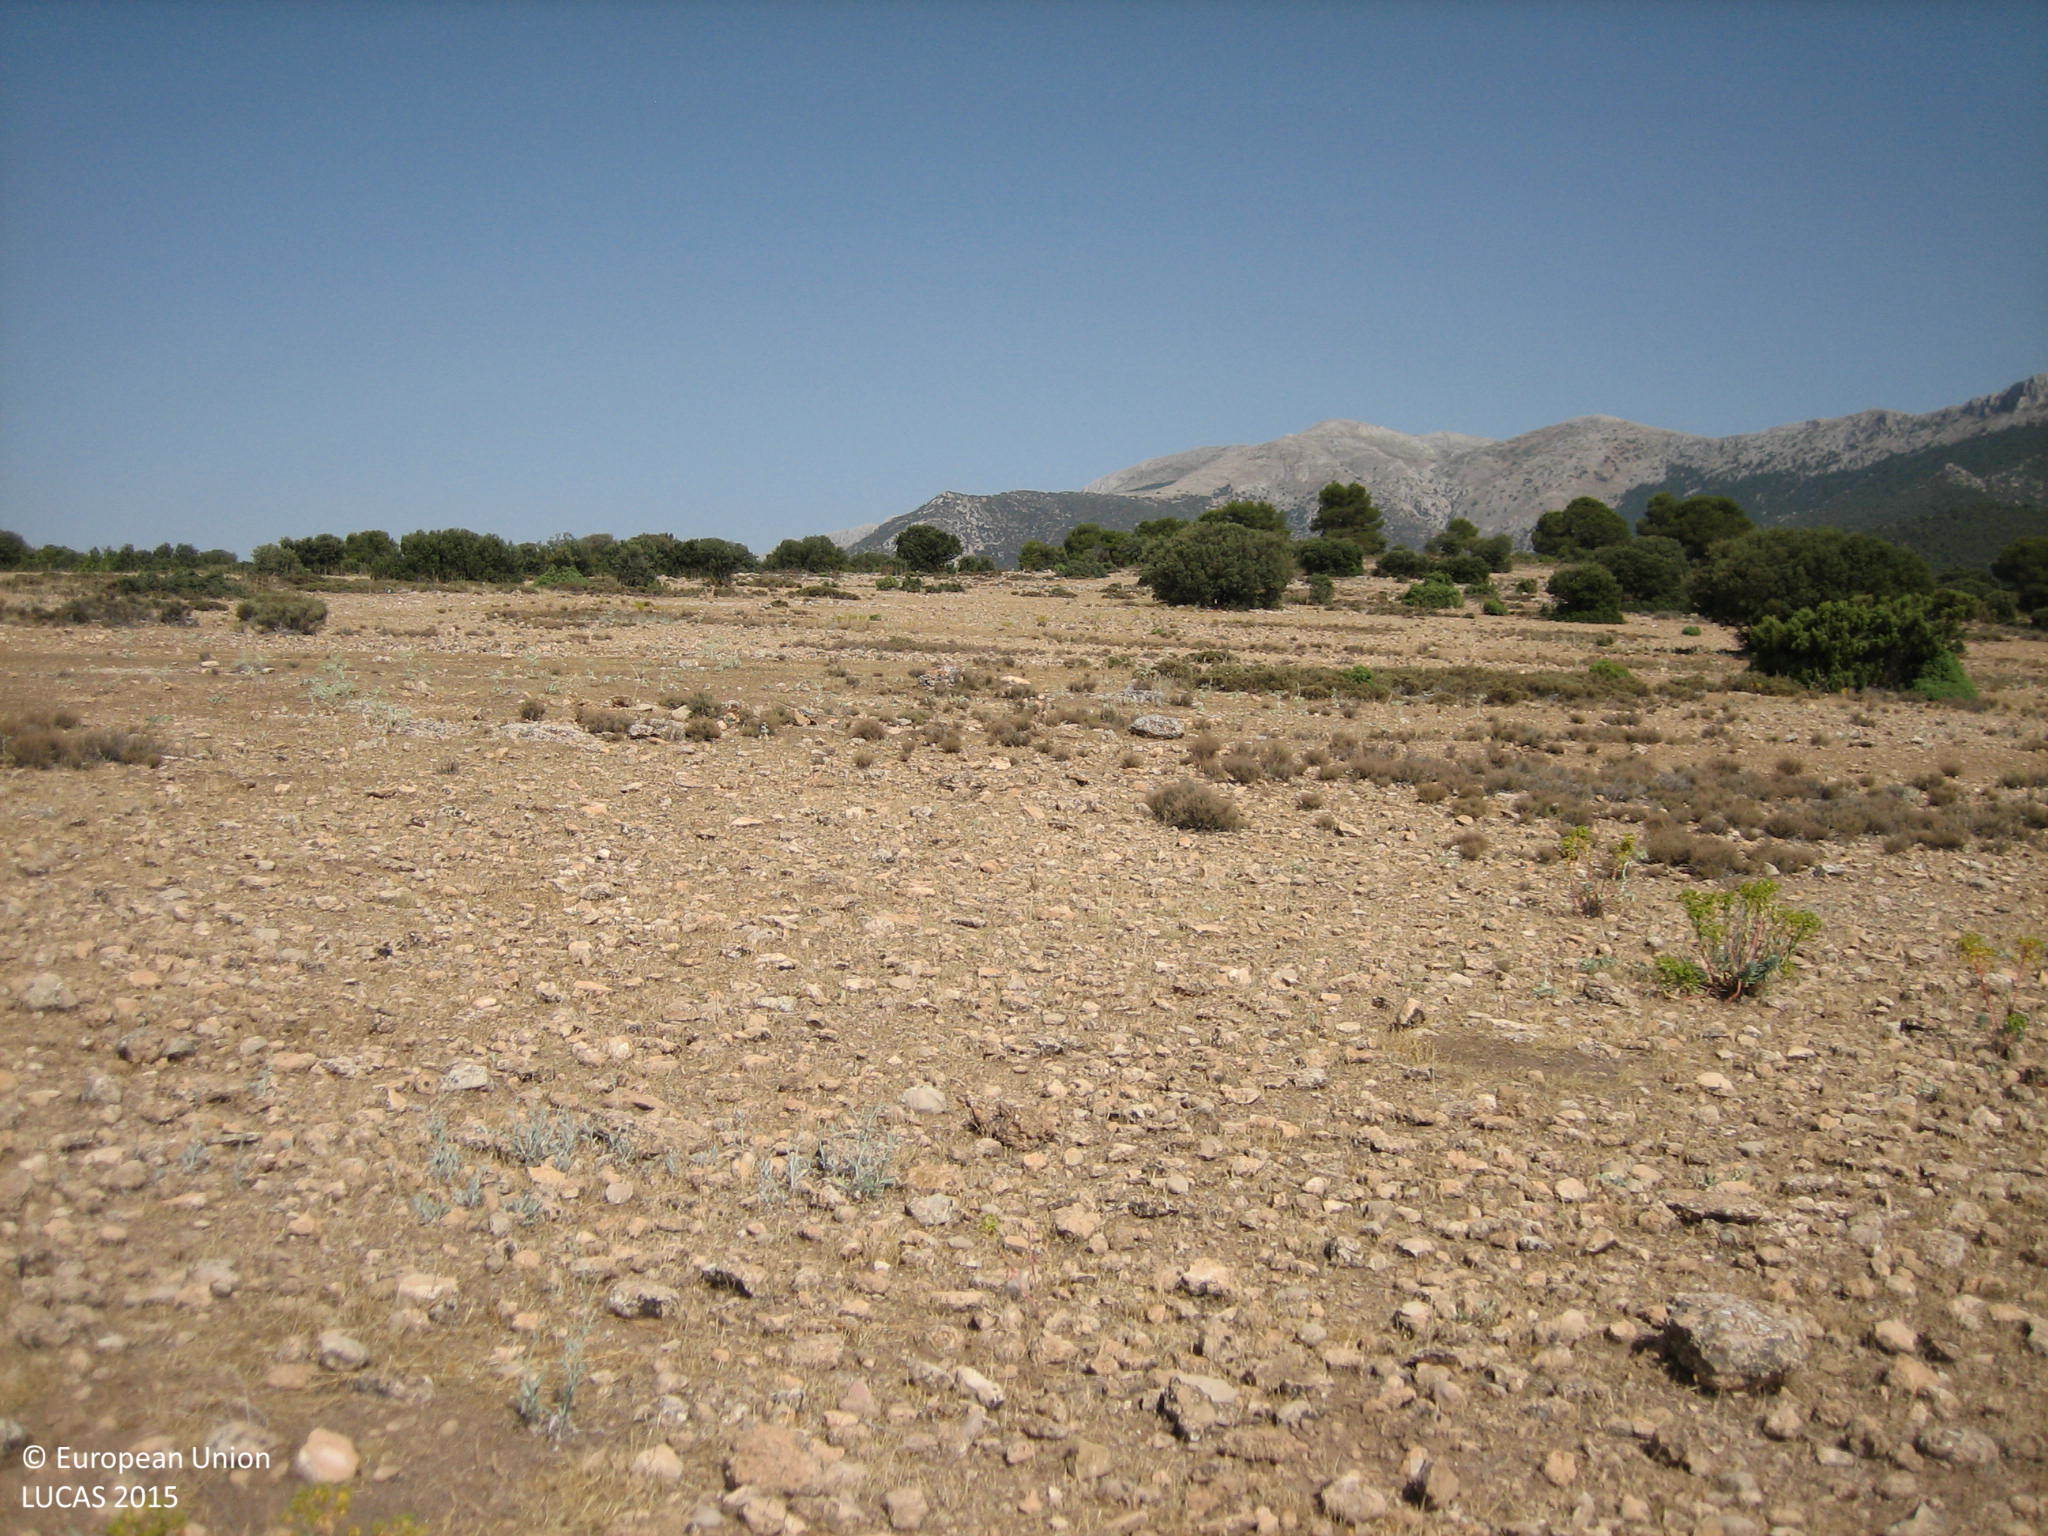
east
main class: Grassland
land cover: Grassland without tree/shrub cover
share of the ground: 10 - 25 %
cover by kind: unconsolidated bare surface 70 %, consolidated bare surface 15 %, herbaceous plants 10 %, shrubs 5 %
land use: Agriculture (excluding fallow land and kitchen gardens)
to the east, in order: Grassland without tree/shrub cover; Shrubland without tree cover
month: July
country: ES
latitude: 37.7009
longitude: -2.2698
